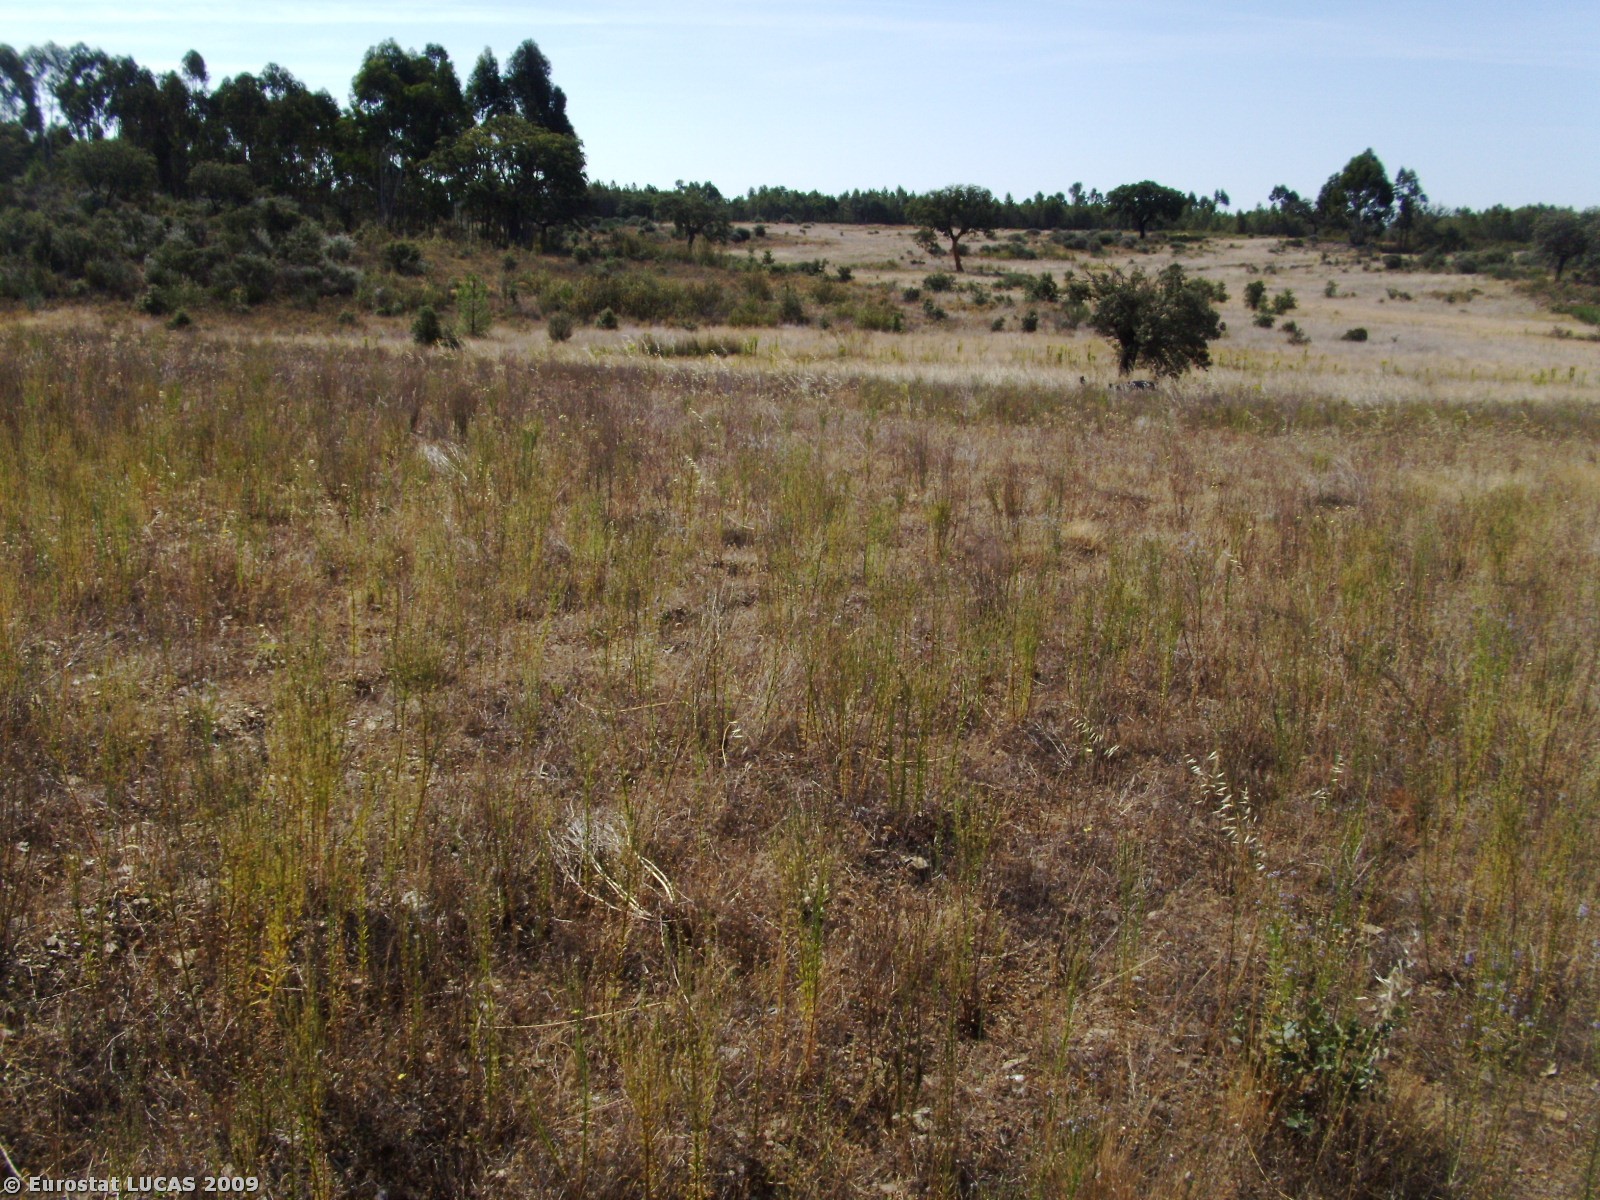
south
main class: Grassland
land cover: Spontaneously vegetated surfaces
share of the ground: > 75 %
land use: Fallow land
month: June
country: PT
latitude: 40.1430
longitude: -7.2717
